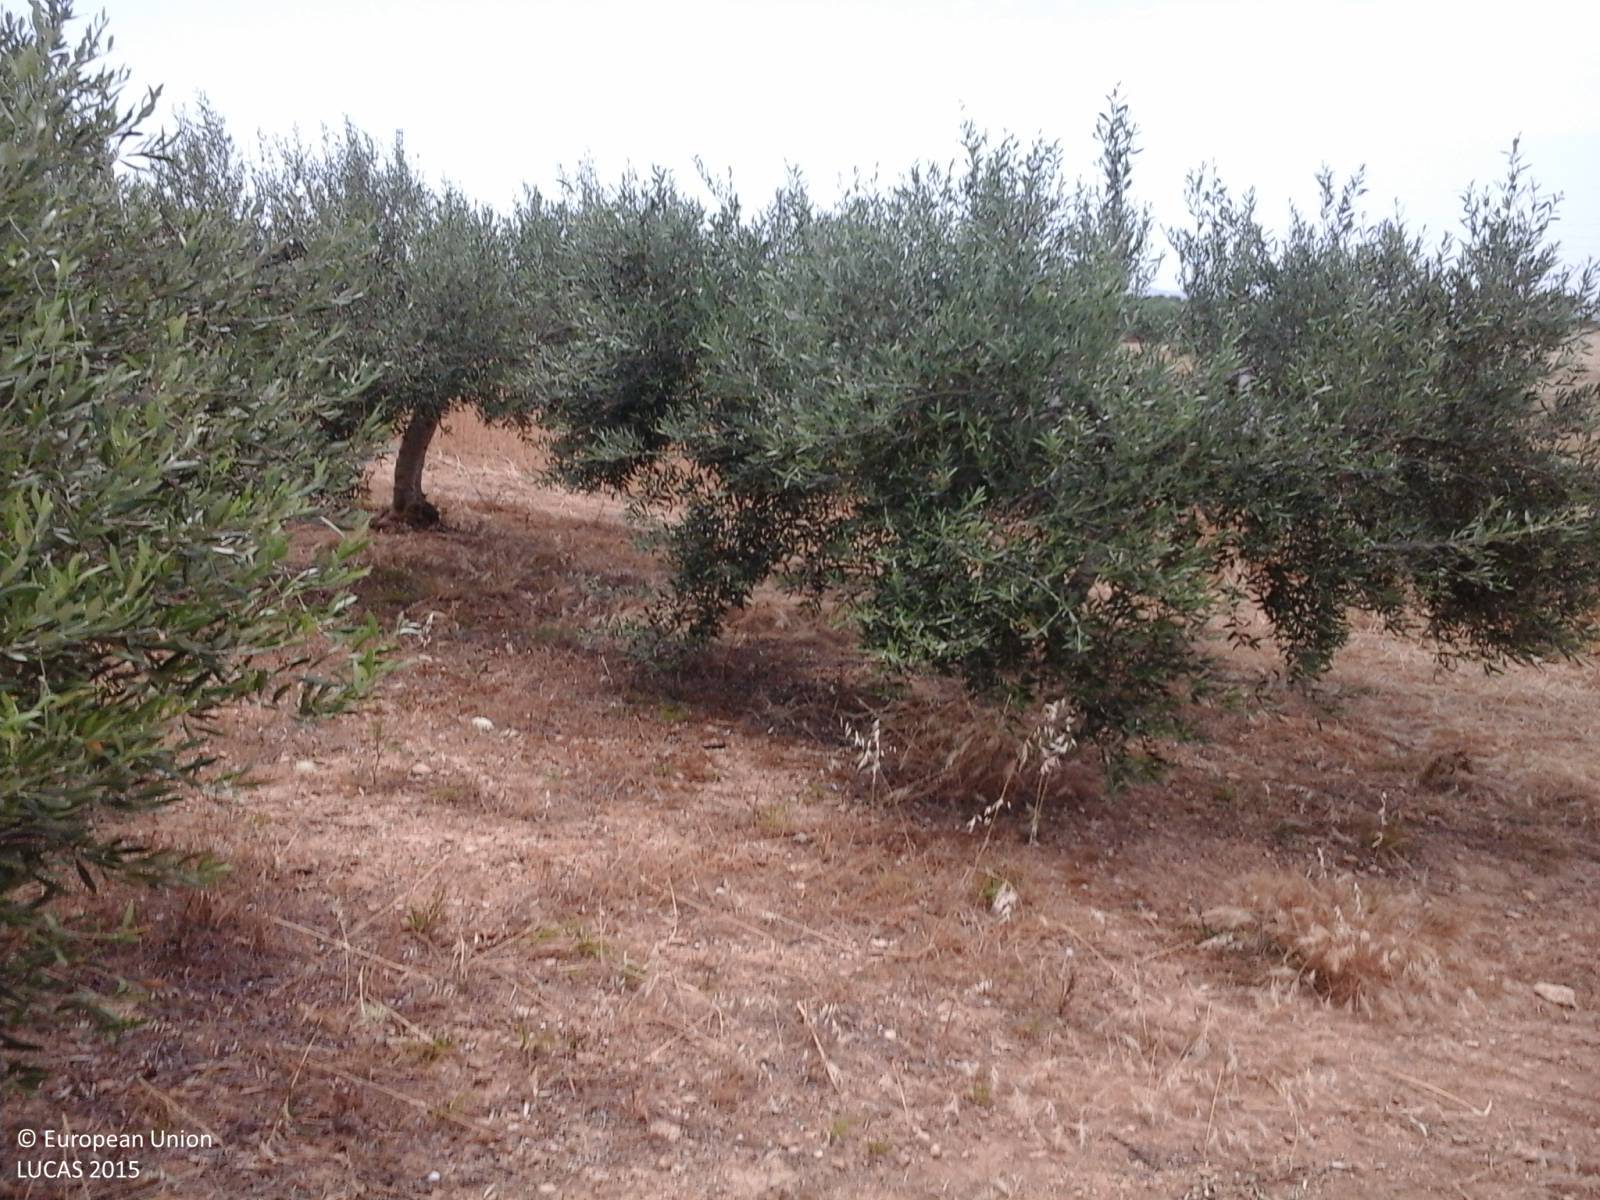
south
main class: Cropland
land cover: Durum wheat
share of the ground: > 75 %
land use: Agriculture (excluding fallow land and kitchen gardens)
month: June
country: IT
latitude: 37.8164
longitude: 12.7626
